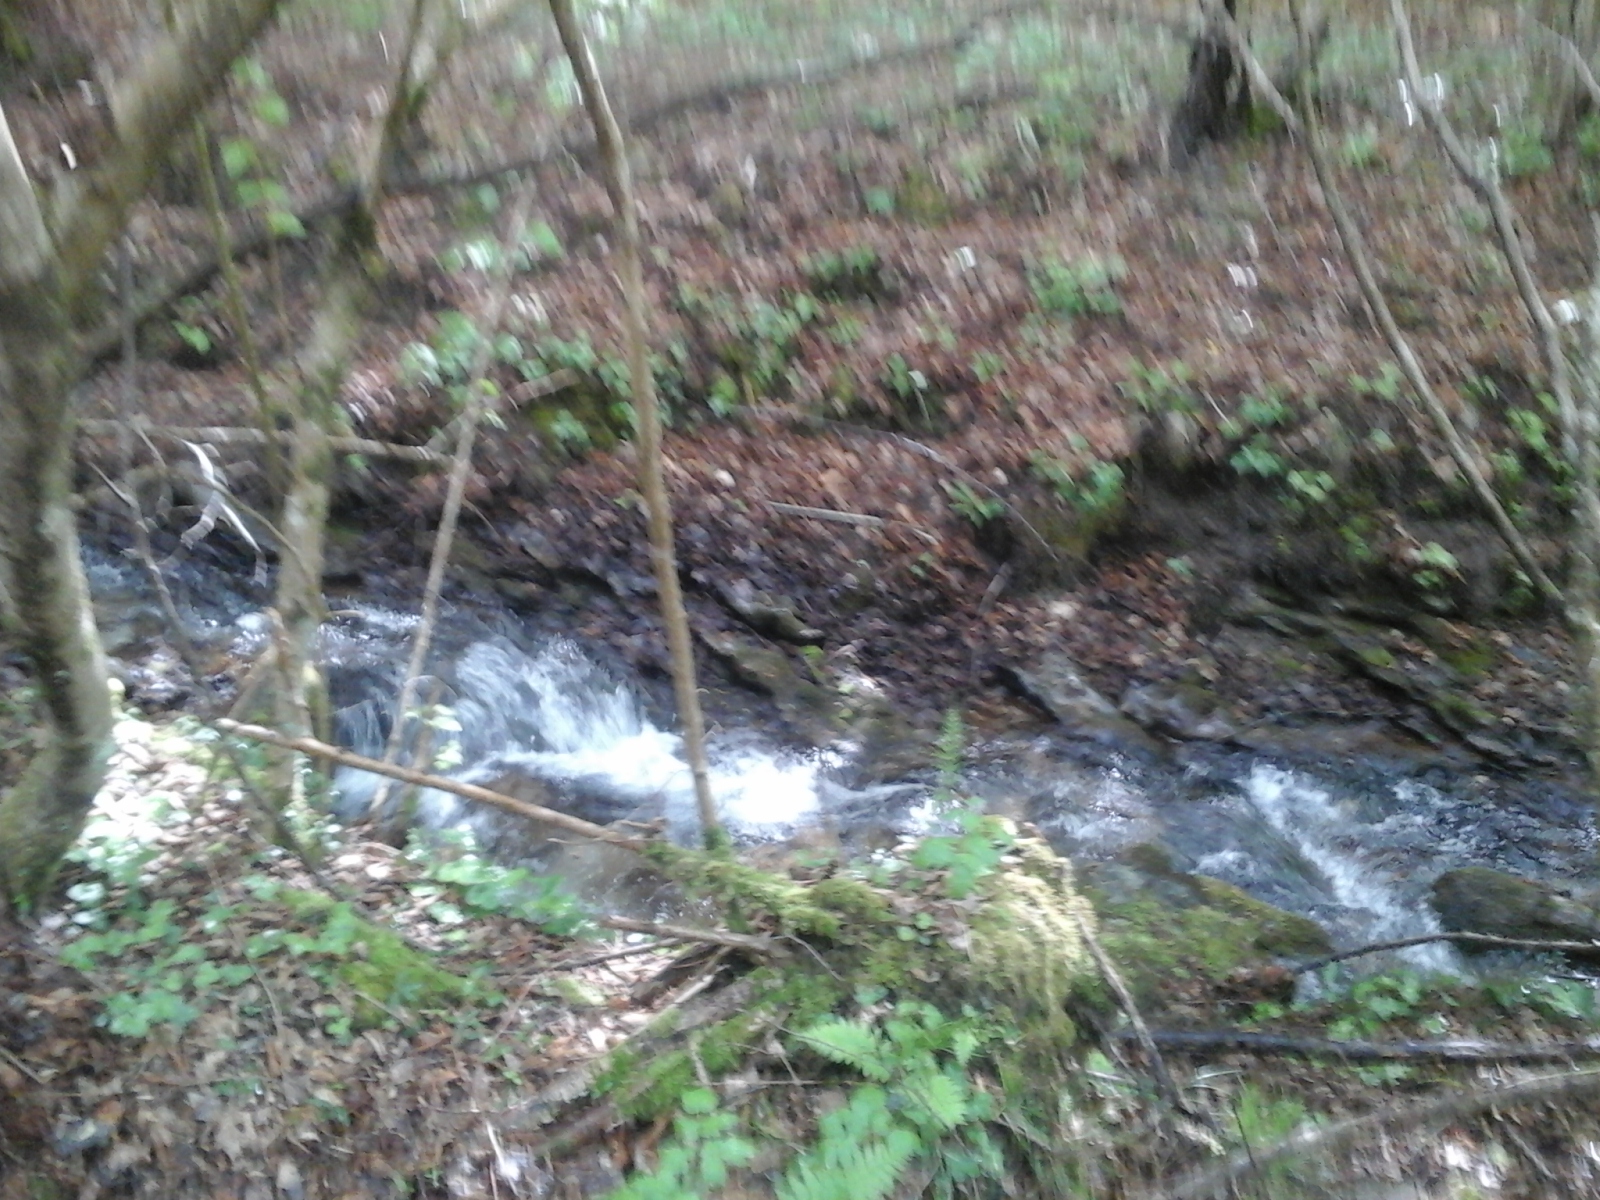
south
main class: Woodland
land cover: Broadleaved woodland
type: mesophytic deciduous forest
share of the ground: > 75 %
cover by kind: broadleaved forest trees 95 %, coniferous forest trees 5 %
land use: Forestry
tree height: > 5 m
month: May
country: IT
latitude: 45.9528
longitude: 10.6570
